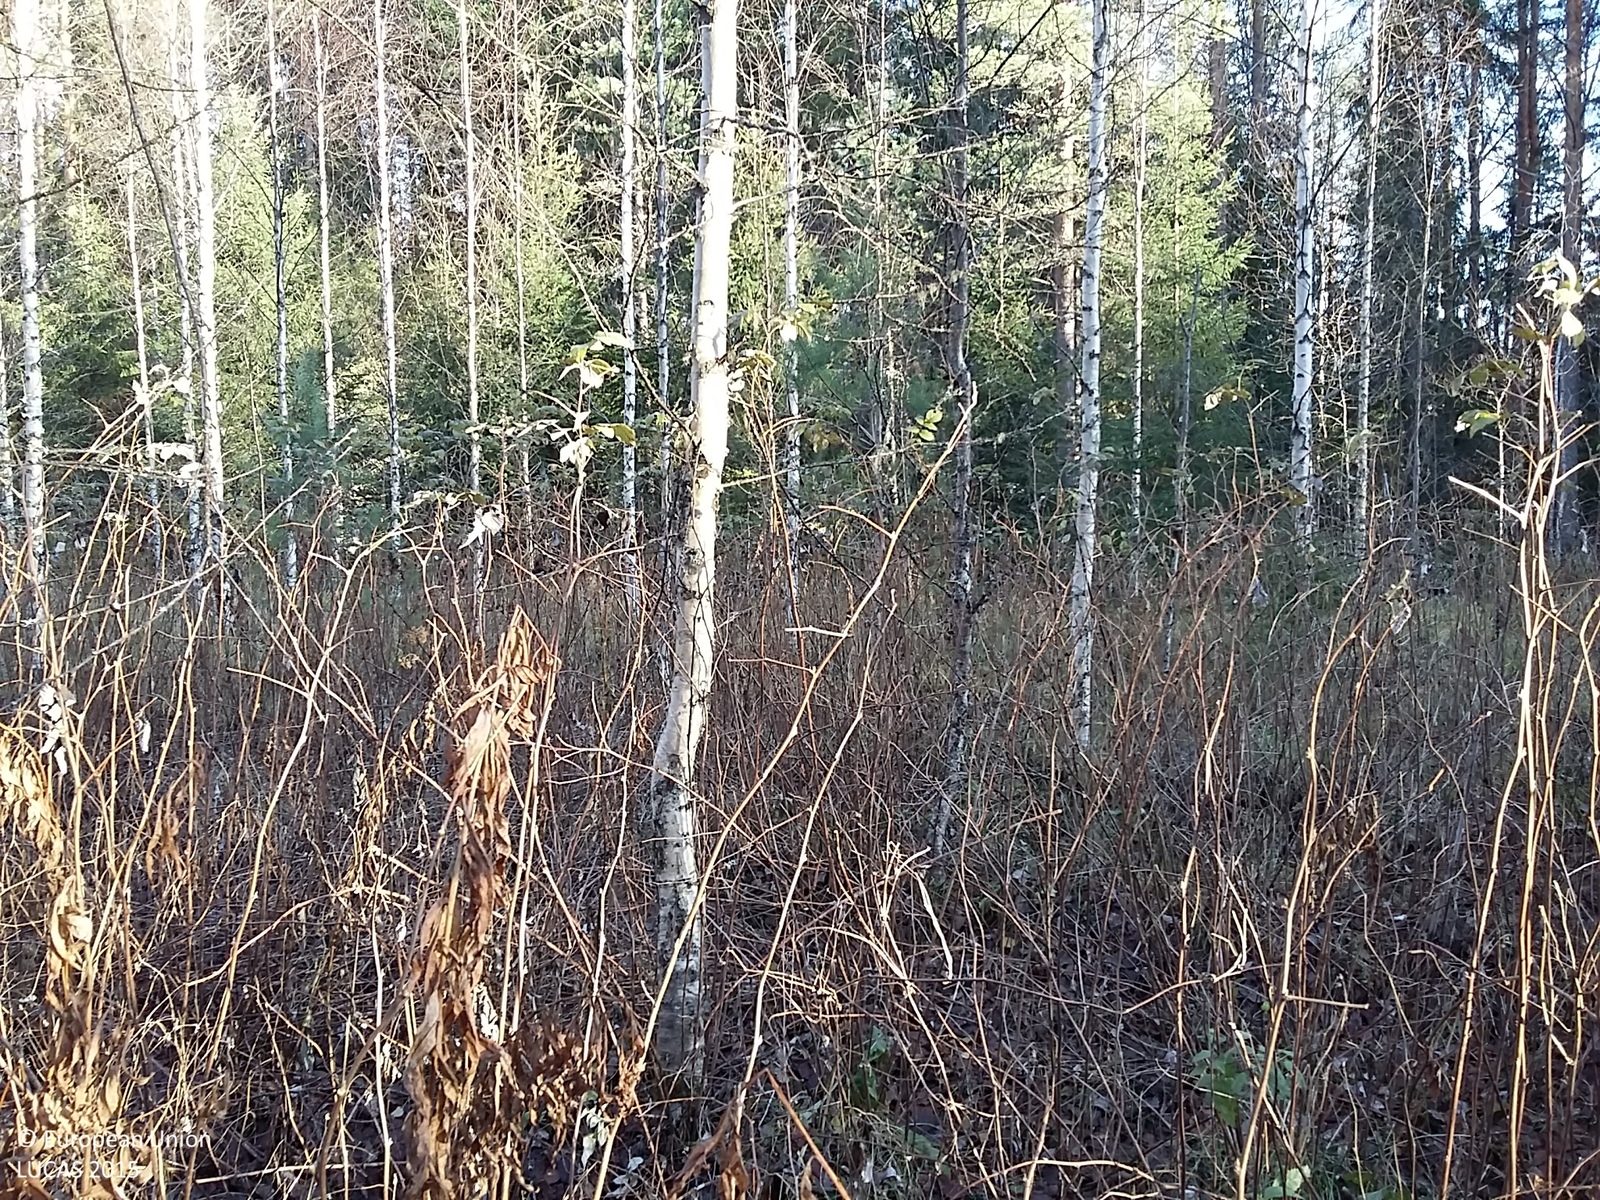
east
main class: Woodland
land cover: Broadleaved woodland
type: non-riverine alder, birch or aspen forest
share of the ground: 50 - 75 %
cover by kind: broadleaved forest trees 70 %, shrubs 15 %, herbaceous plants 15 %
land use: Forestry
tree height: > 5 m
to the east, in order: Broadleaved woodland; Ditches and canals; Other coniferous woodland; Other mixed woodland; Shrubland with sparse tree cover; Inland fresh running water; Shrubland with sparse tree cover; Broadleaved woodland; Ditches and canals; Broadleaved woodland; Ditches and canals; Broadleaved woodland; Ditches and canals; Broadleaved woodland
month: October
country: FI
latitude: 64.5498
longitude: 25.5450
